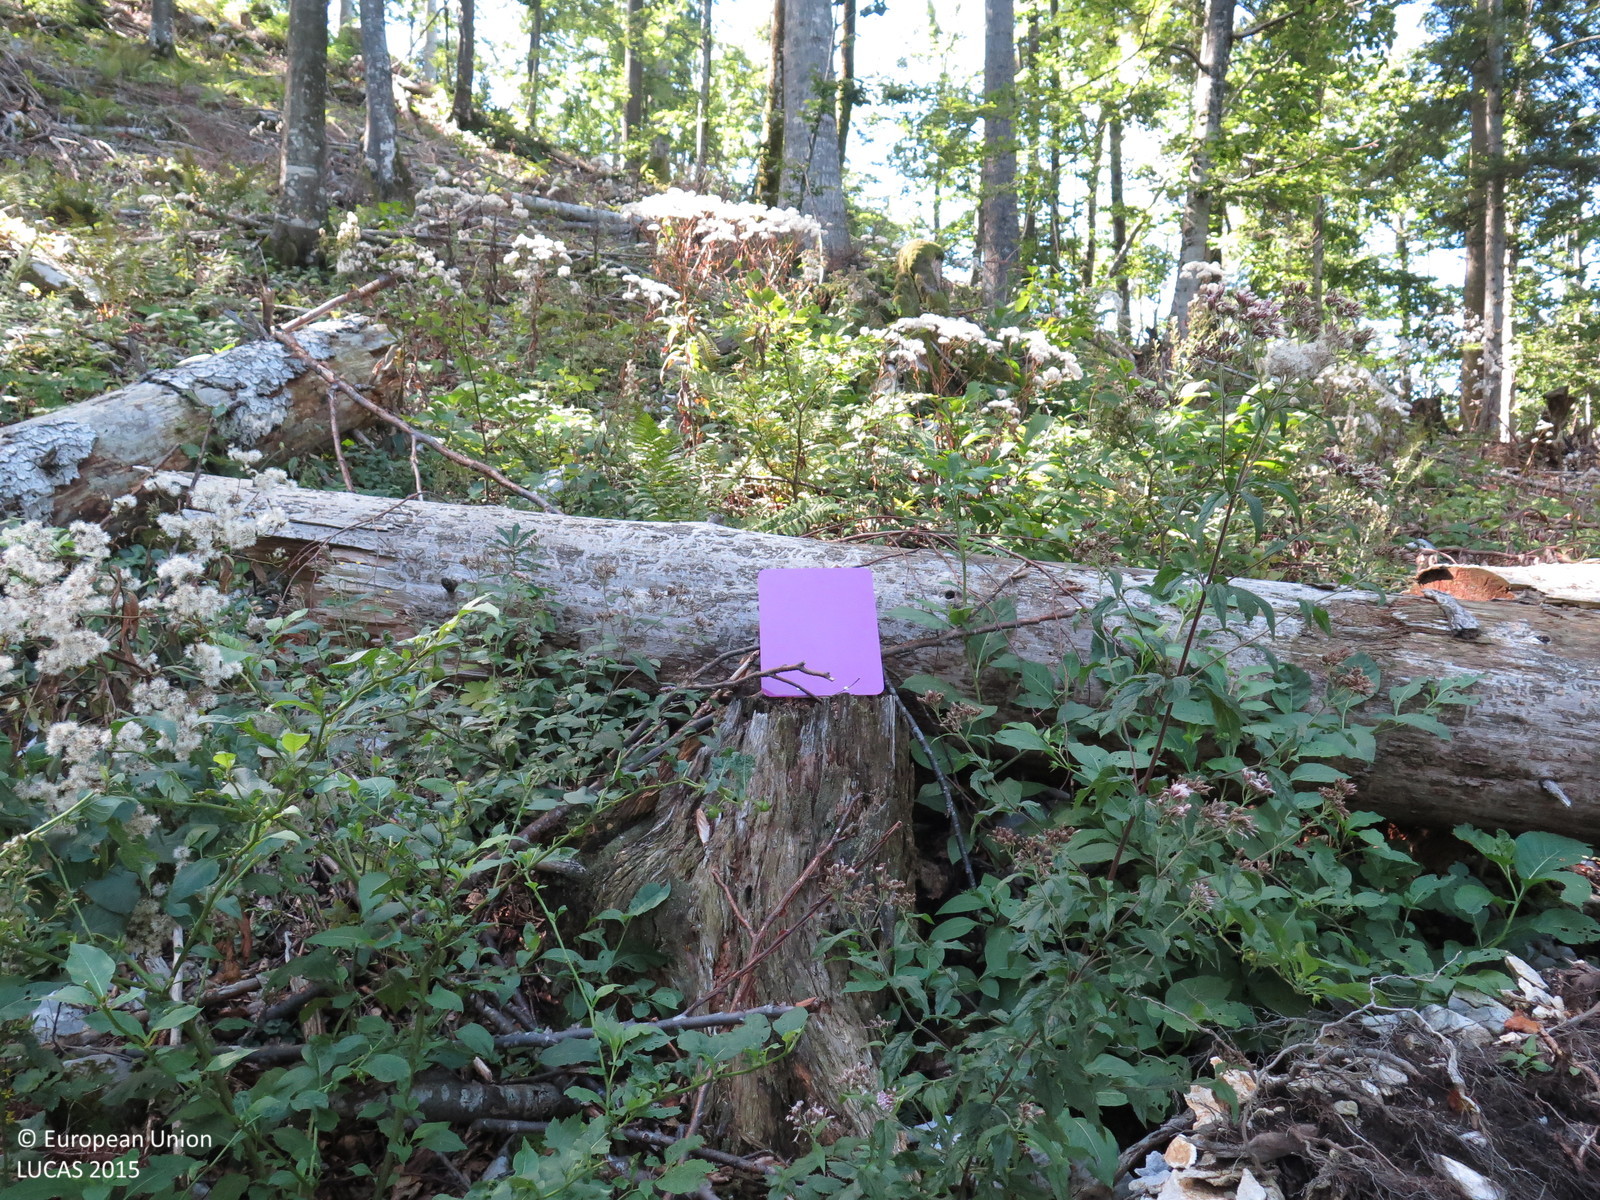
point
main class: Woodland
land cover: Other mixed woodland
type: mountainous beech forest
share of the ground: > 75 %
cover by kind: broadleaved forest trees 70 %, coniferous forest trees 25 %, unconsolidated bare surface 5 %
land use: Forestry
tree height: > 5 m
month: September
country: HR
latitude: 45.4736
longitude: 14.6643
